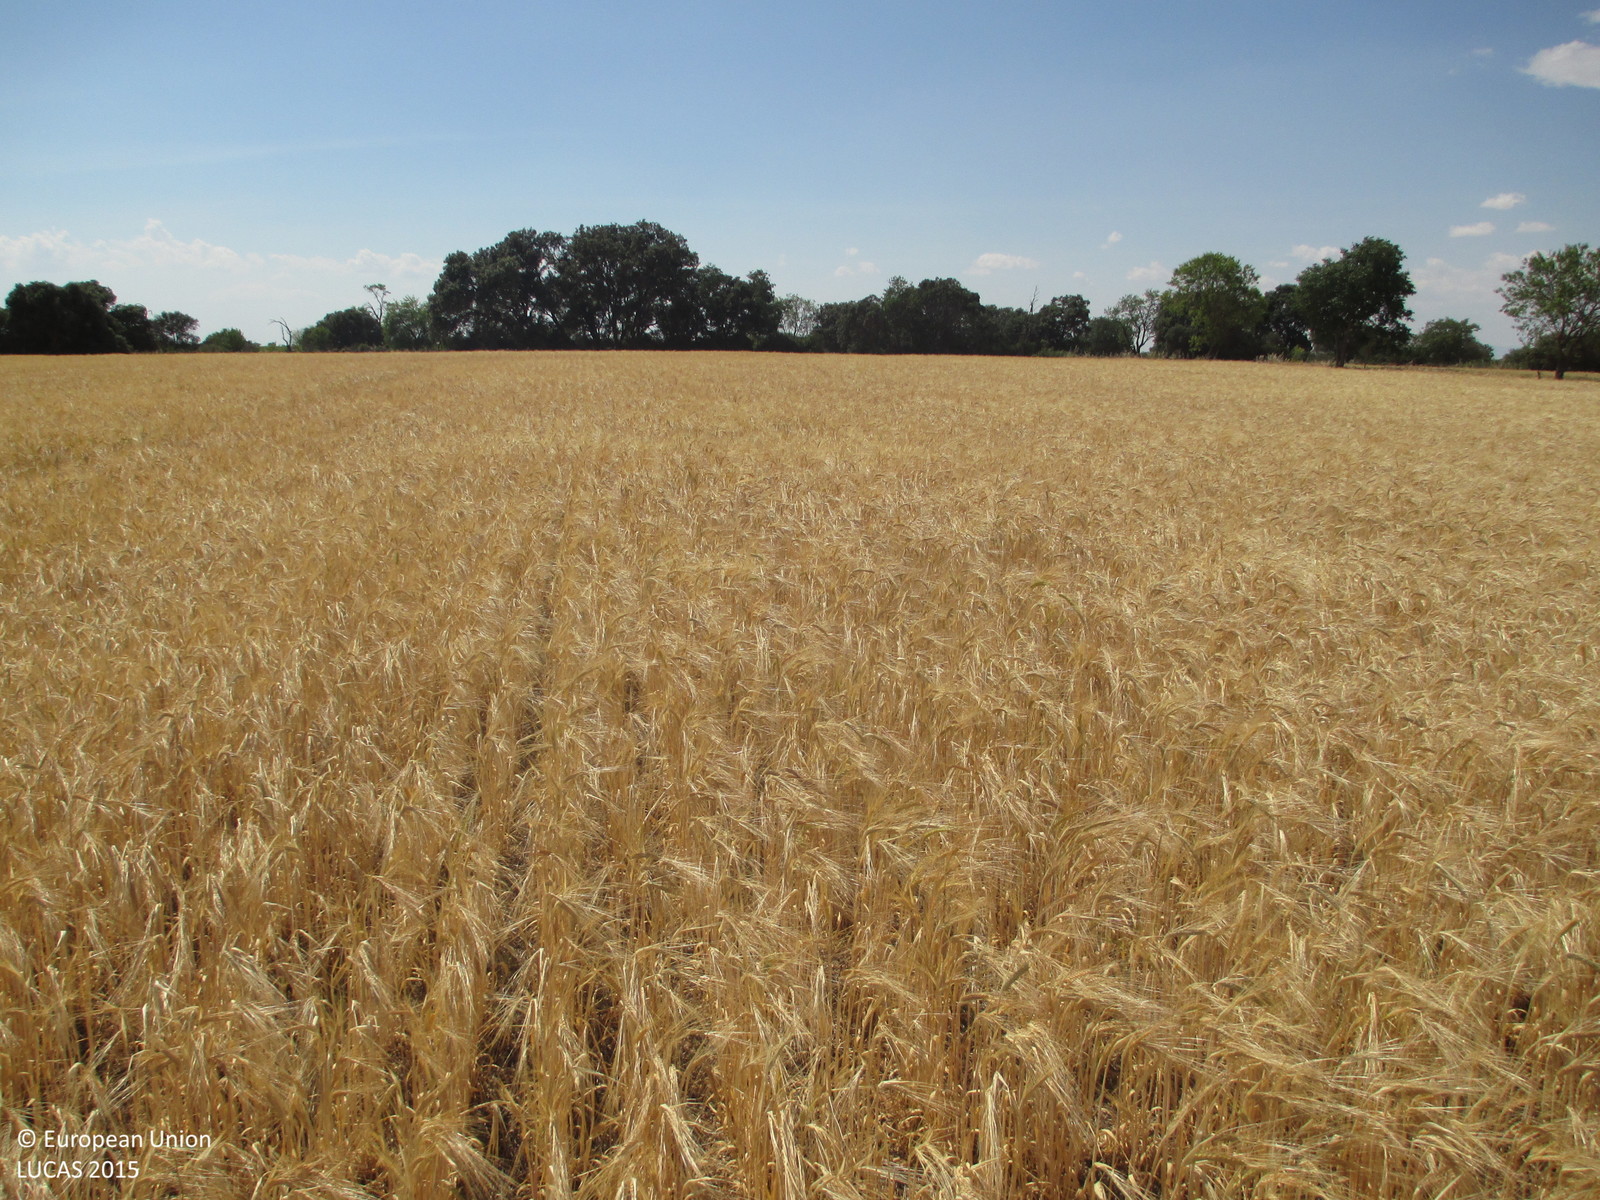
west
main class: Cropland
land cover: Barley
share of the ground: > 75 %
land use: Agriculture (excluding fallow land and kitchen gardens)
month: May
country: ES
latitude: 41.9225
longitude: 0.0099
